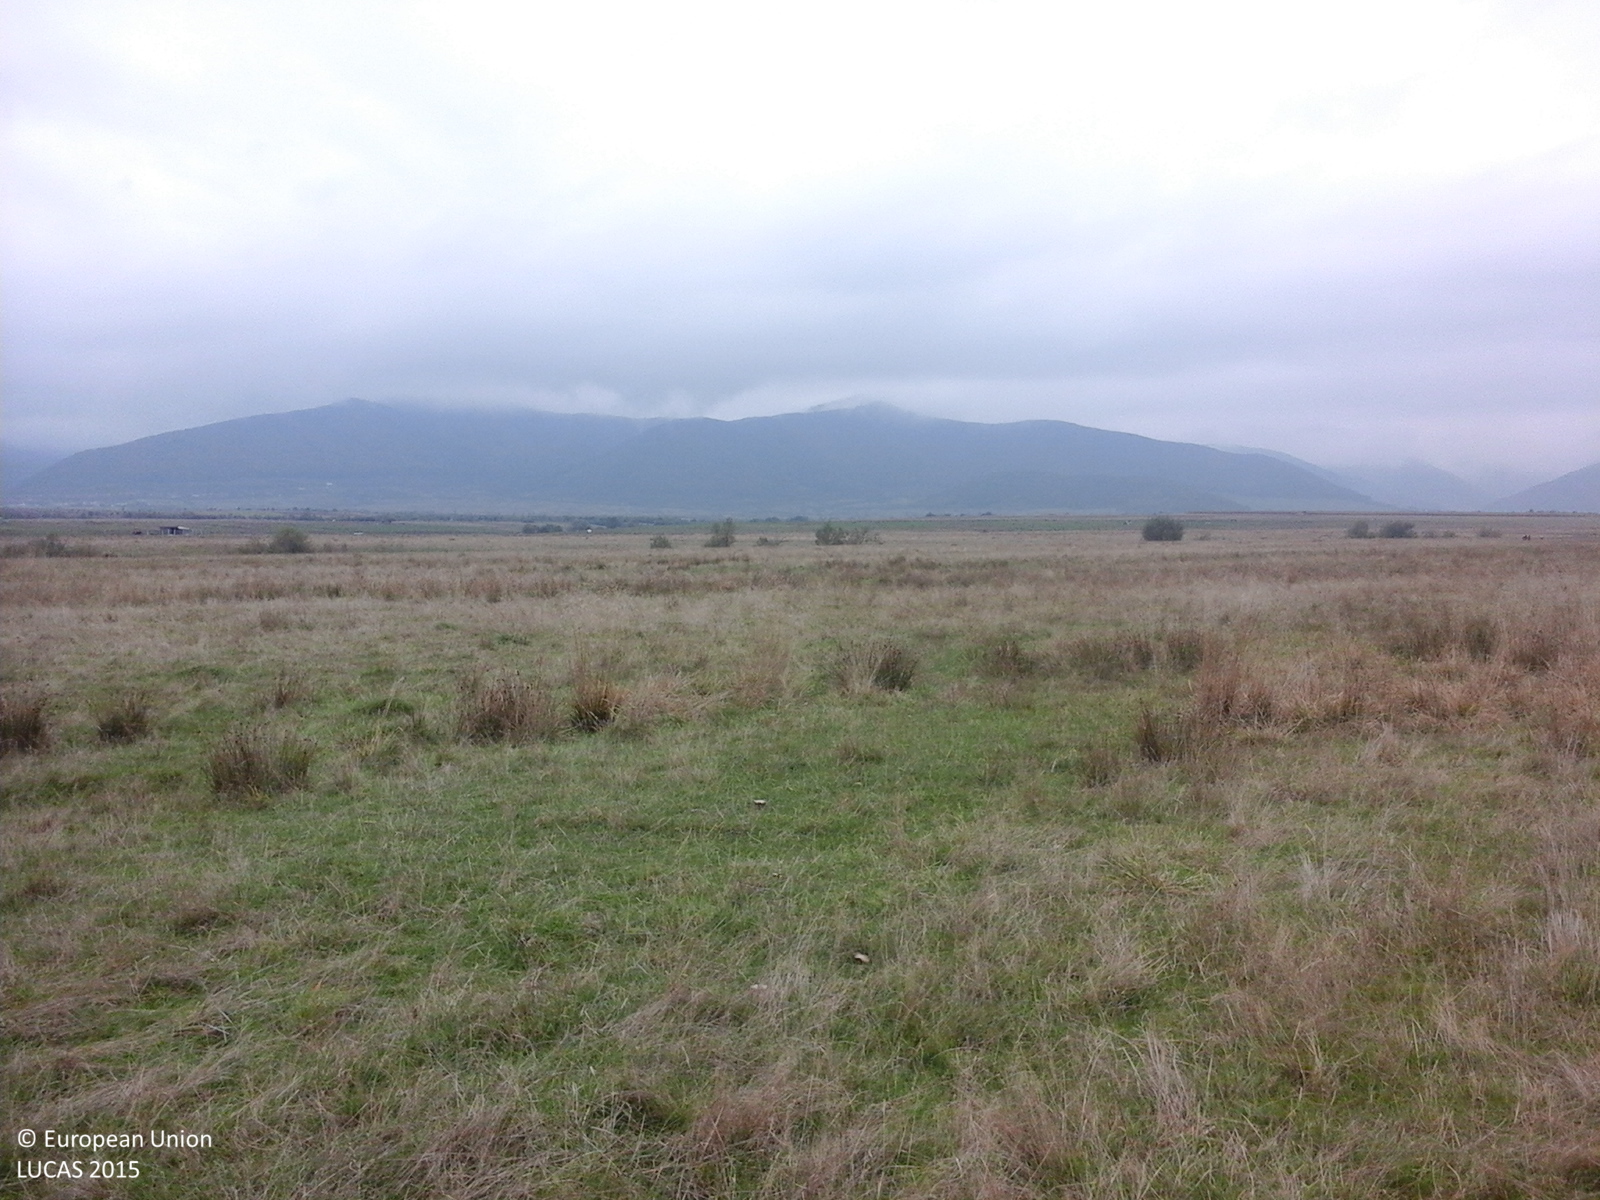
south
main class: Grassland
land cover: Grassland without tree/shrub cover
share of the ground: > 75 %
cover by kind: herbaceous plants 100 %
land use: Agriculture (excluding fallow land and kitchen gardens)
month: October
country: RO
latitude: 45.7655
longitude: 24.0496
